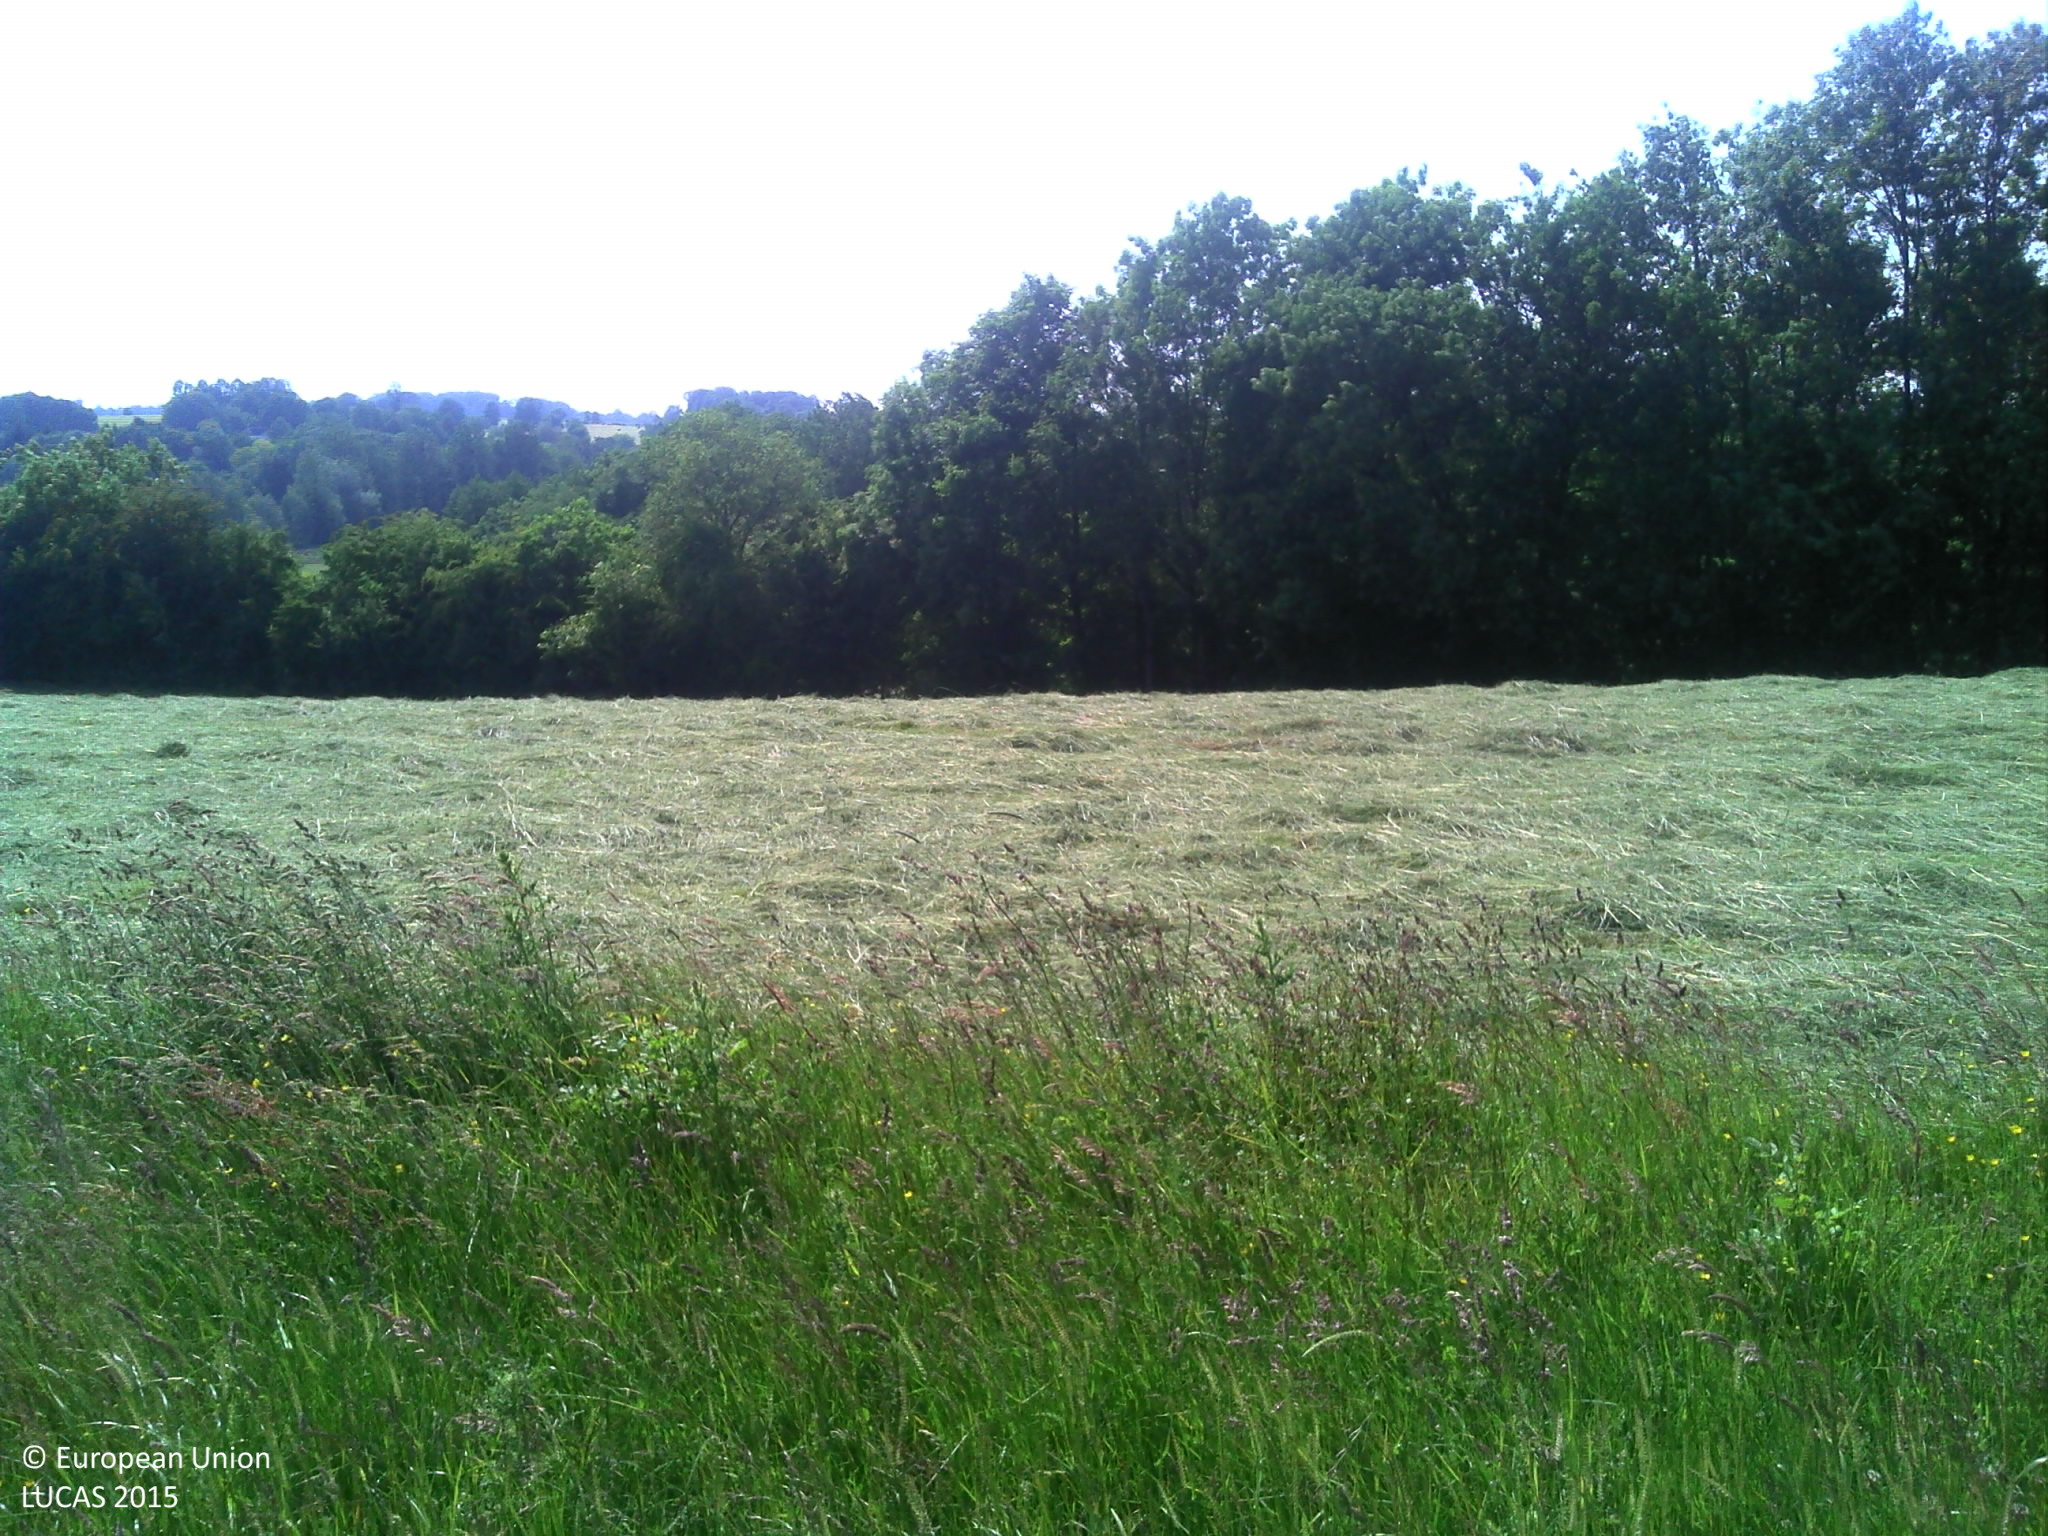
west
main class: Grassland
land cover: Grassland without tree/shrub cover
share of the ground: > 75 %
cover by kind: herbaceous plants 100 %
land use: Agriculture (excluding fallow land and kitchen gardens)
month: June
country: FR
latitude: 49.7443
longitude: 4.1248
